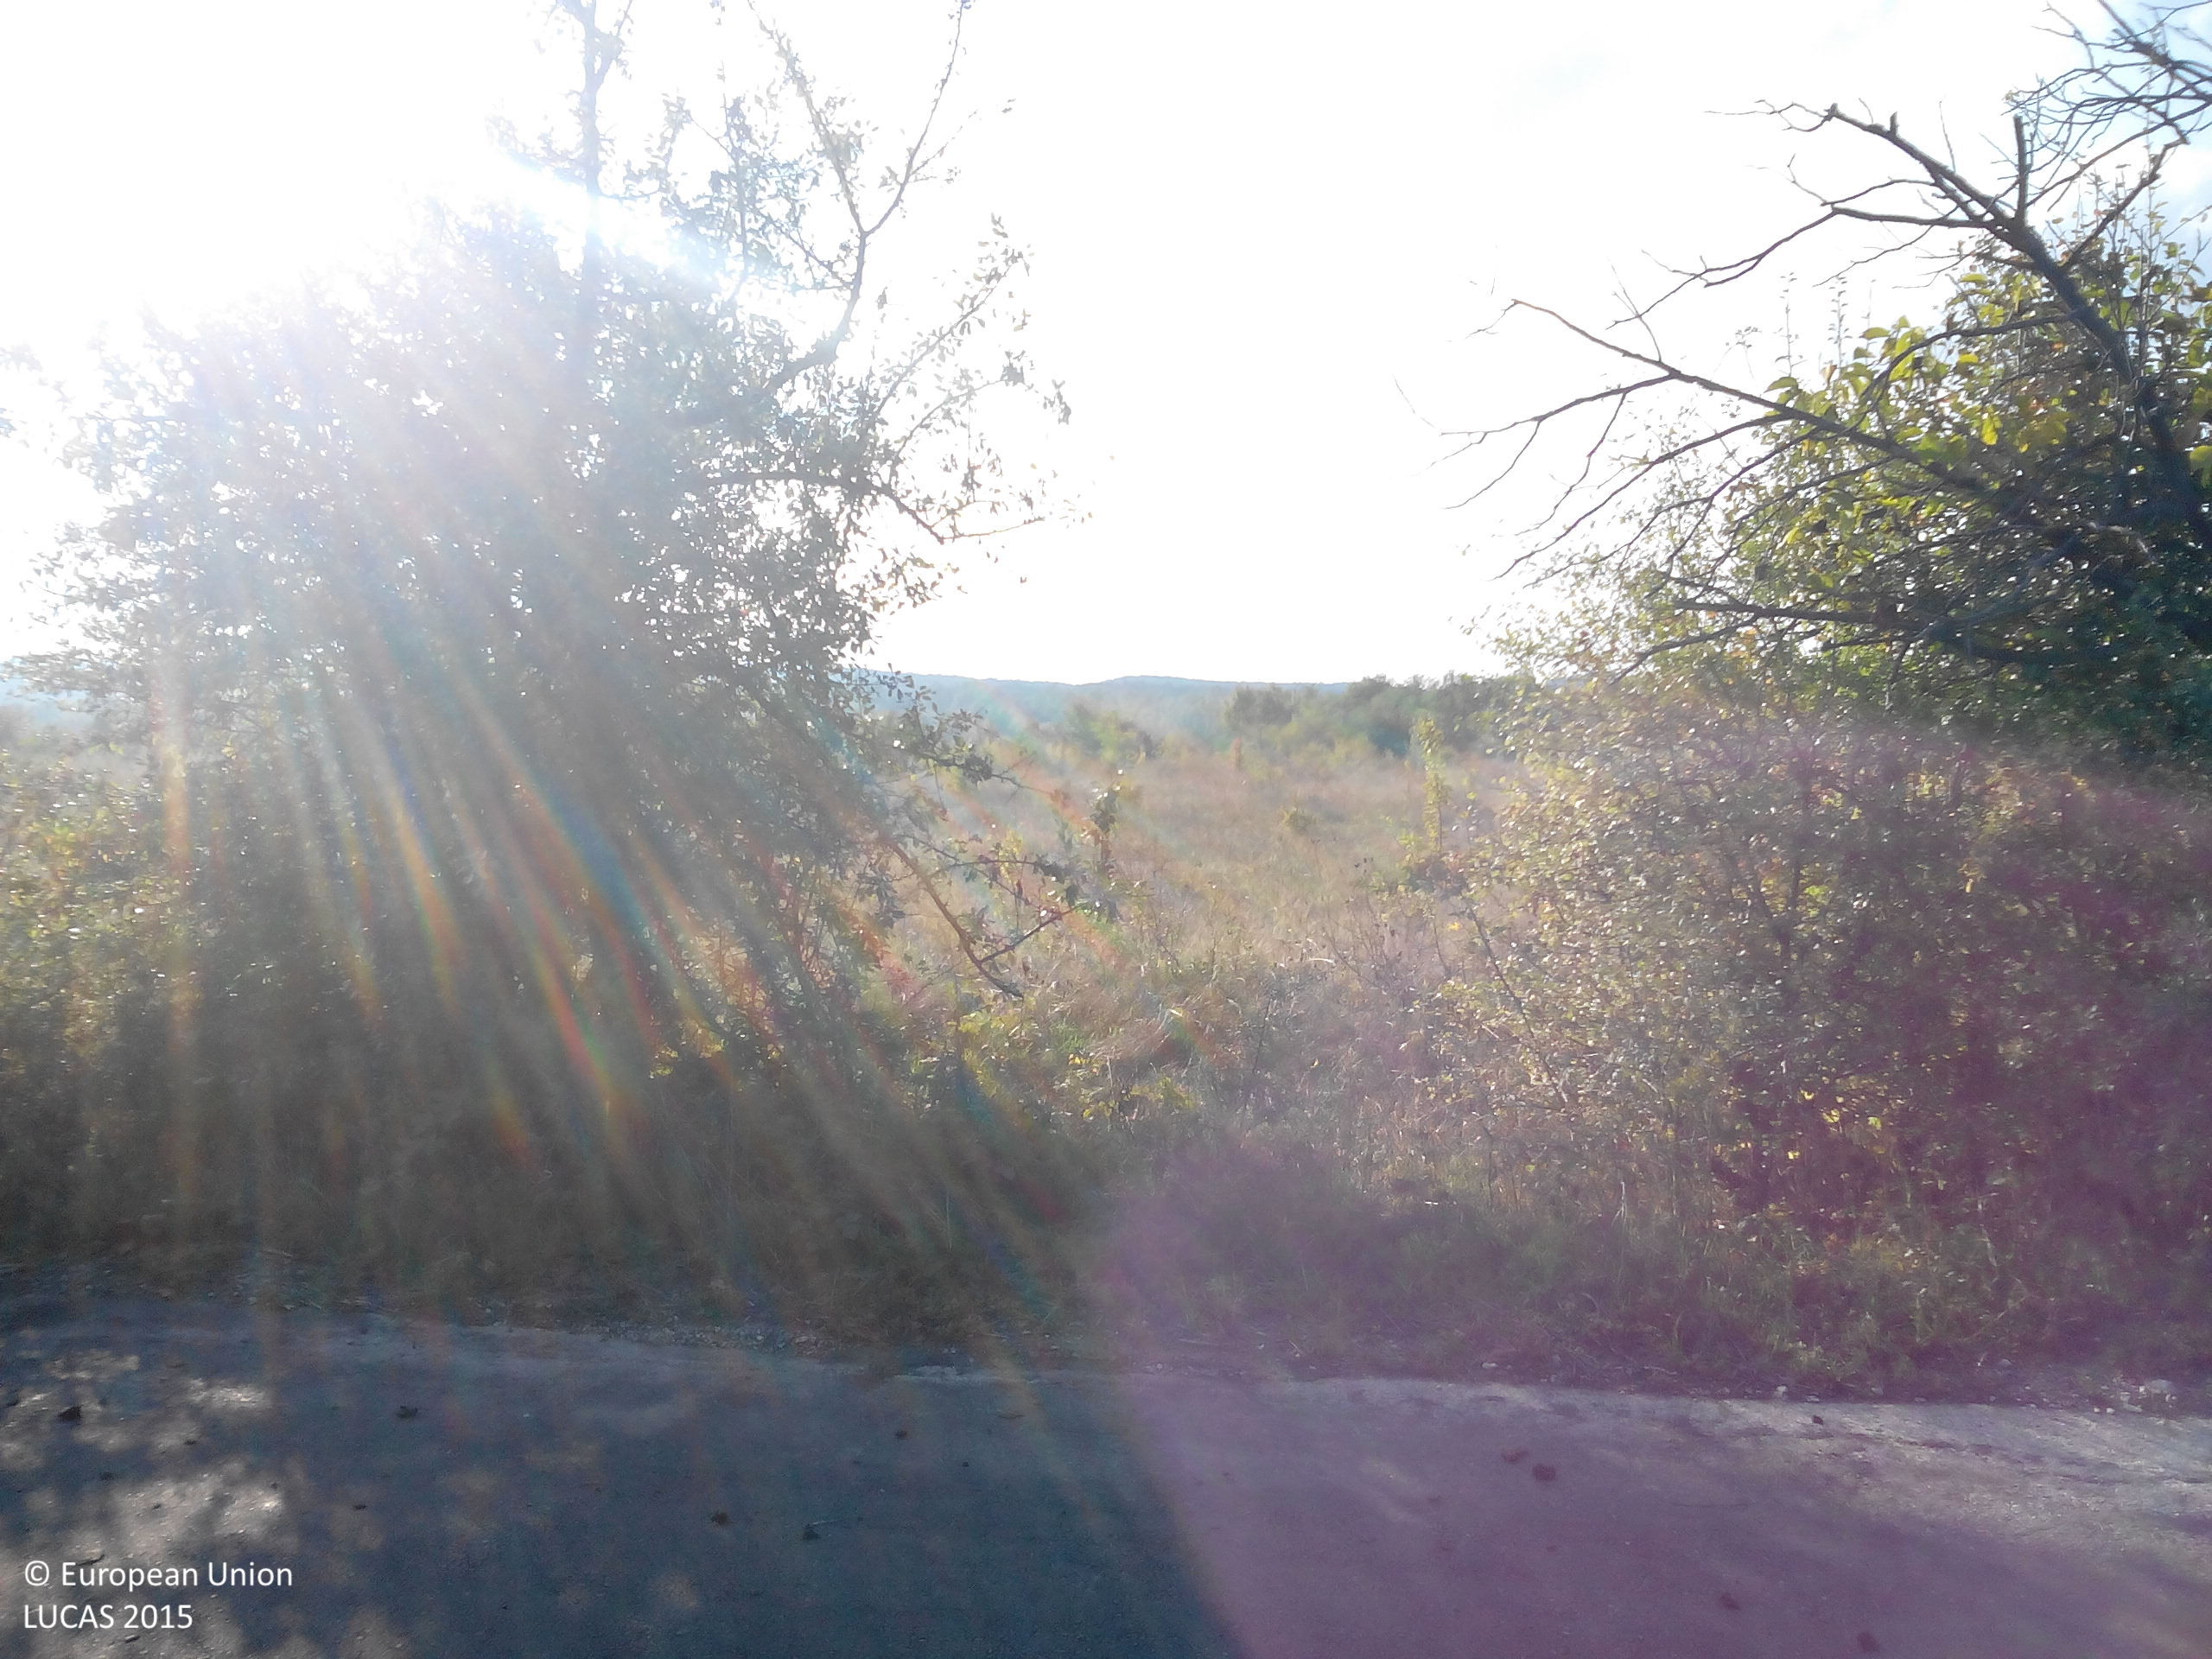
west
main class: Woodland
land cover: Broadleaved woodland
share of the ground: > 75 %
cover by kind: broadleaved forest trees 80 %, shrubs 20 %
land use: Road transport
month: October
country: BG
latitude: 43.2801
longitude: 23.9124
